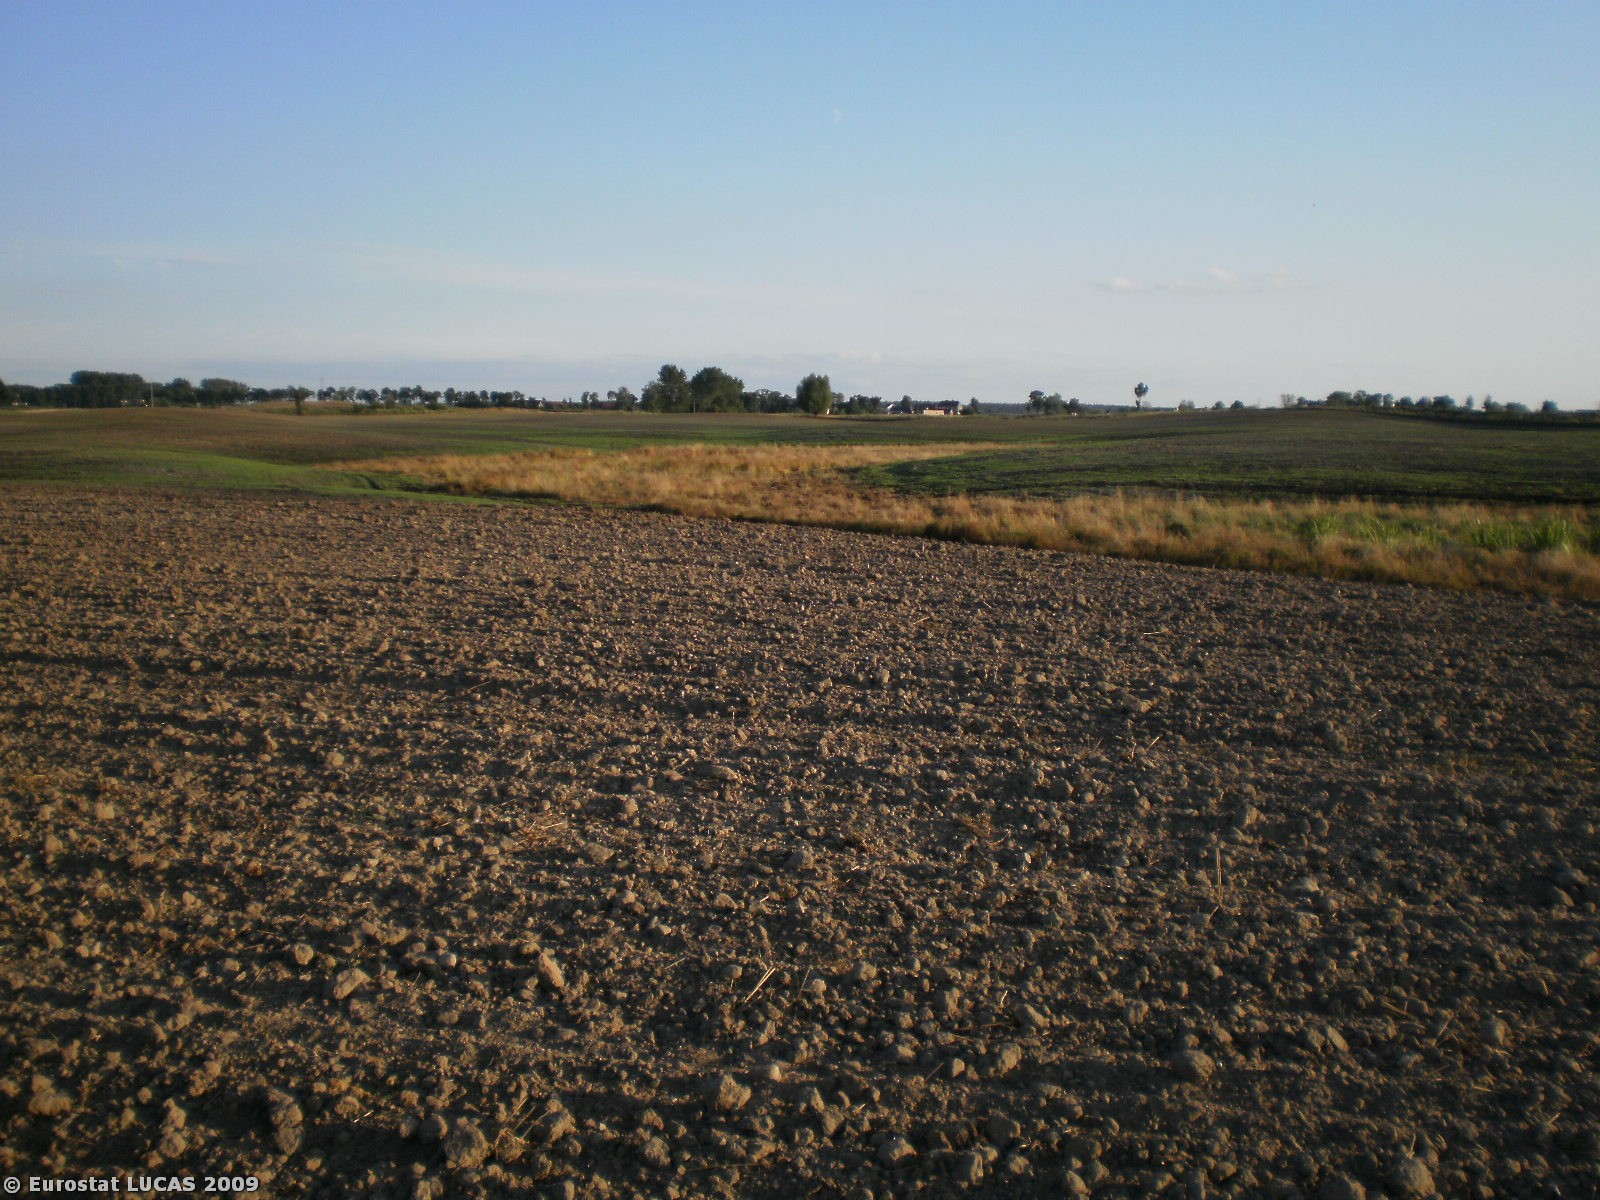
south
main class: Cropland
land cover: Triticale
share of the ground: < 10 %
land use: Agriculture (excluding fallow land and kitchen gardens)
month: August
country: PL
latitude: 53.8698
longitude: 21.6865
